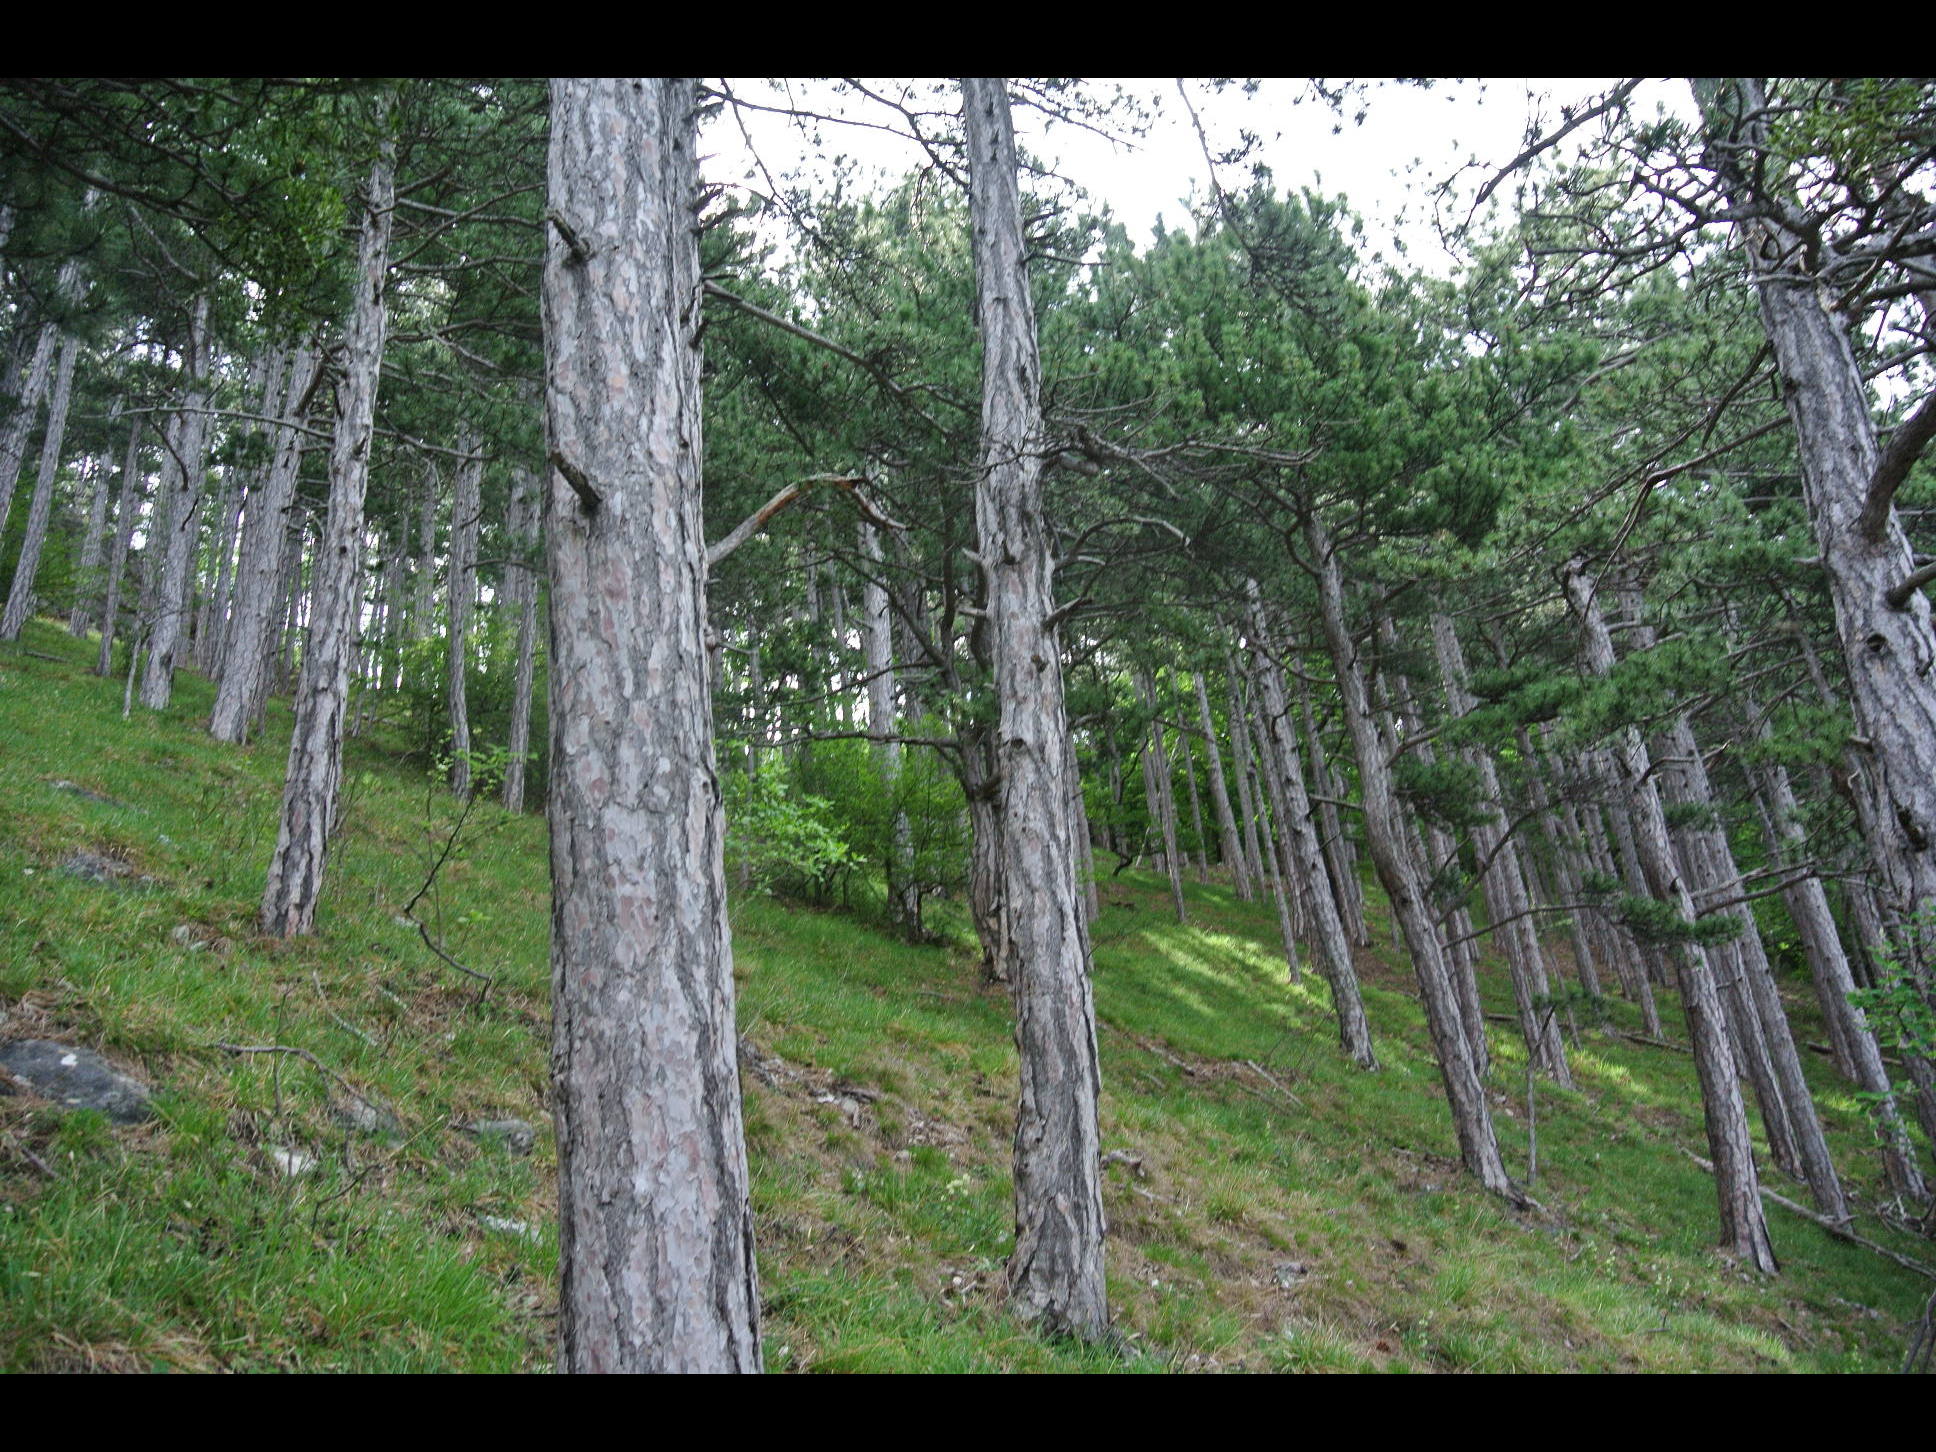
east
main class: Woodland
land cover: Pine dominated coniferous woodland
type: alpine coniferous forest
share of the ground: > 75 %
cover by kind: coniferous forest trees 85 %, herbaceous plants 10 %, unconsolidated bare surface 5 %
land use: Forestry
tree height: > 5 m
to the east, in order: Pine dominated coniferous woodland; Pine dominated mixed woodland; Broadleaved woodland; Other coniferous woodland; Tracks; Pine dominated coniferous woodland
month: May
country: AT
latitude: 47.8540
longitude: 16.1380
